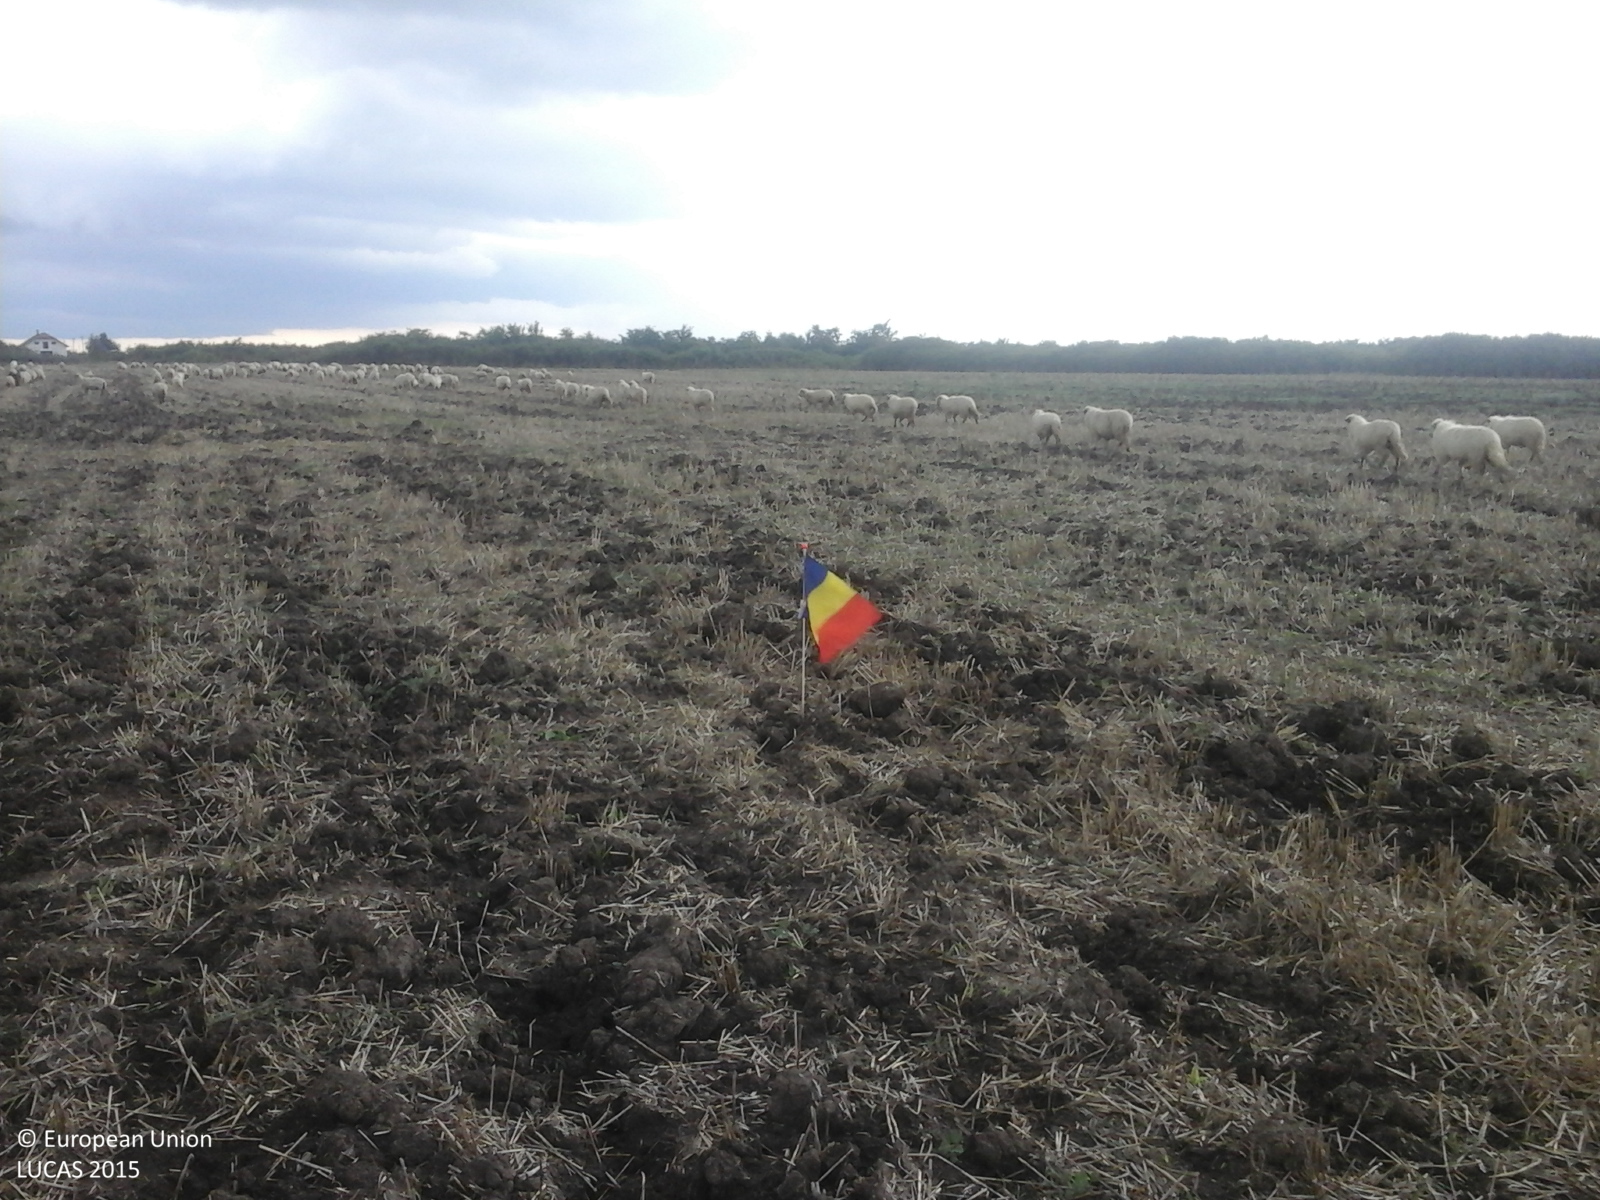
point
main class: Cropland
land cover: Oats
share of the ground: 10 - 25 %
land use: Agriculture (excluding fallow land and kitchen gardens)
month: August
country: RO
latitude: 45.4814
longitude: 21.0939
